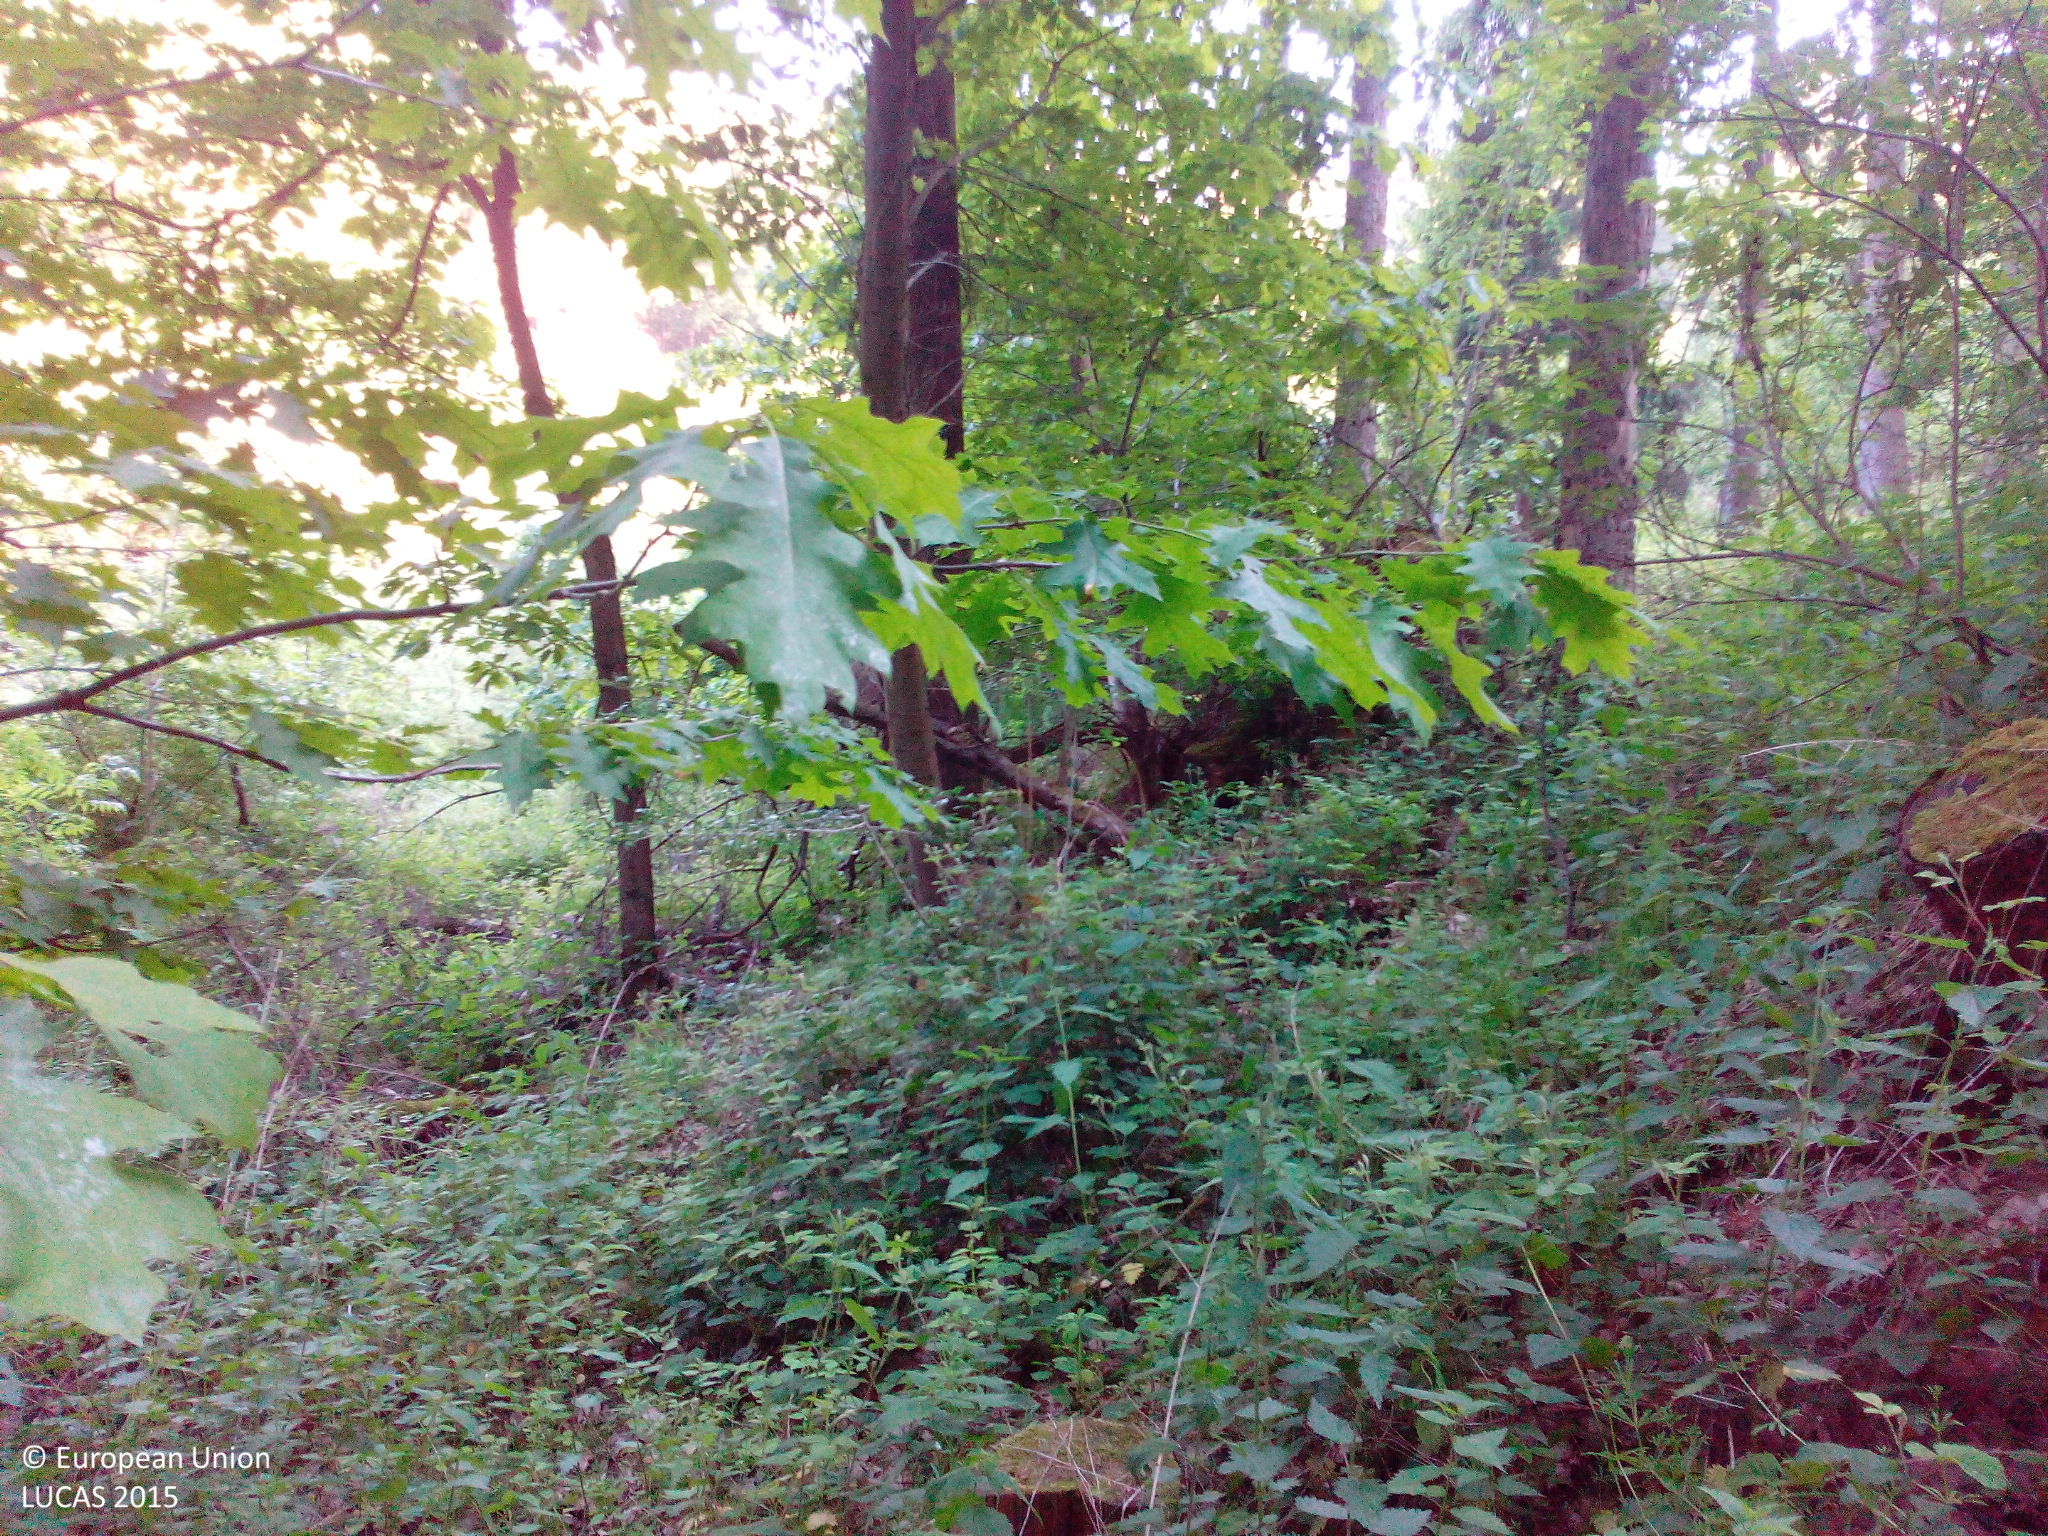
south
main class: Woodland
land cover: Broadleaved woodland
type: mesophytic deciduous forest
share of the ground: > 75 %
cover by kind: broadleaved forest trees 100 %
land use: Forestry
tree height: > 5 m
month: June
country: DE
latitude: 51.4072
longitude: 7.9733
